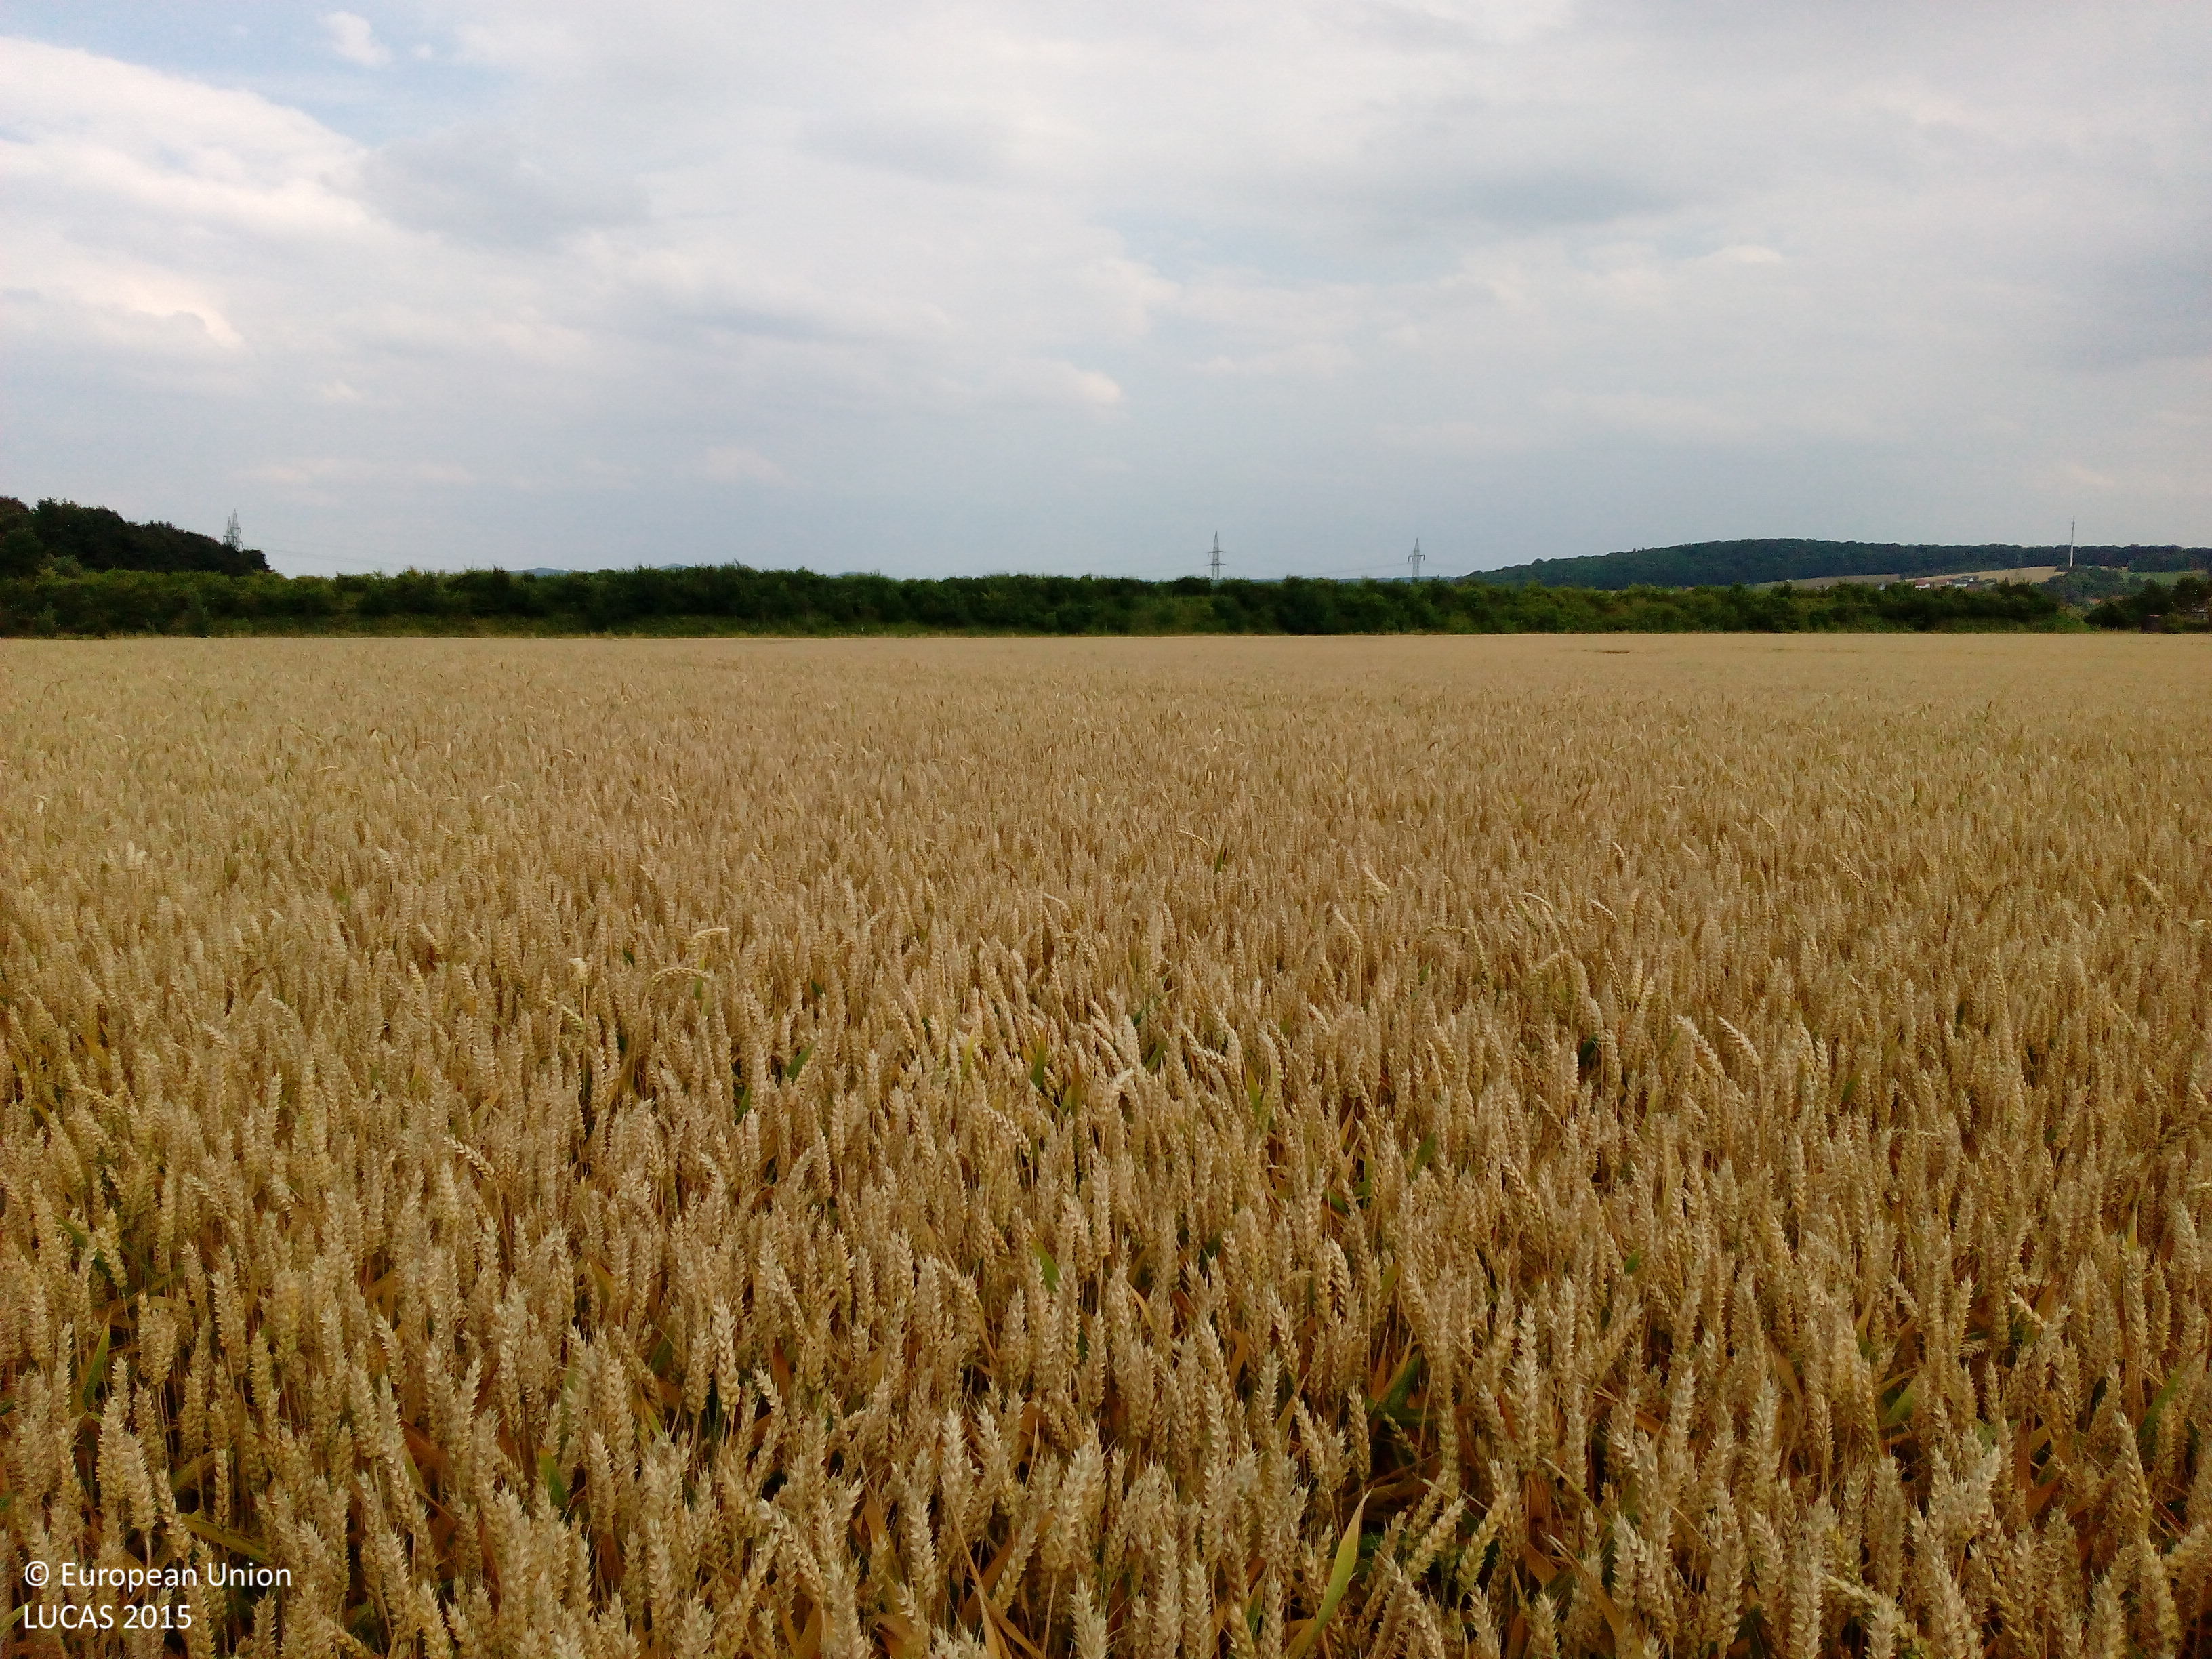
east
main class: Cropland
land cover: Common wheat
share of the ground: > 75 %
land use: Agriculture (excluding fallow land and kitchen gardens)
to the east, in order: Common wheat; Grassland without tree/shrub cover; Shrubland with sparse tree cover; Grassland without tree/shrub cover; Paved roads, cycling and walking lanes; Grass margins
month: July
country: DE
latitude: 51.4786
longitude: 9.8705
